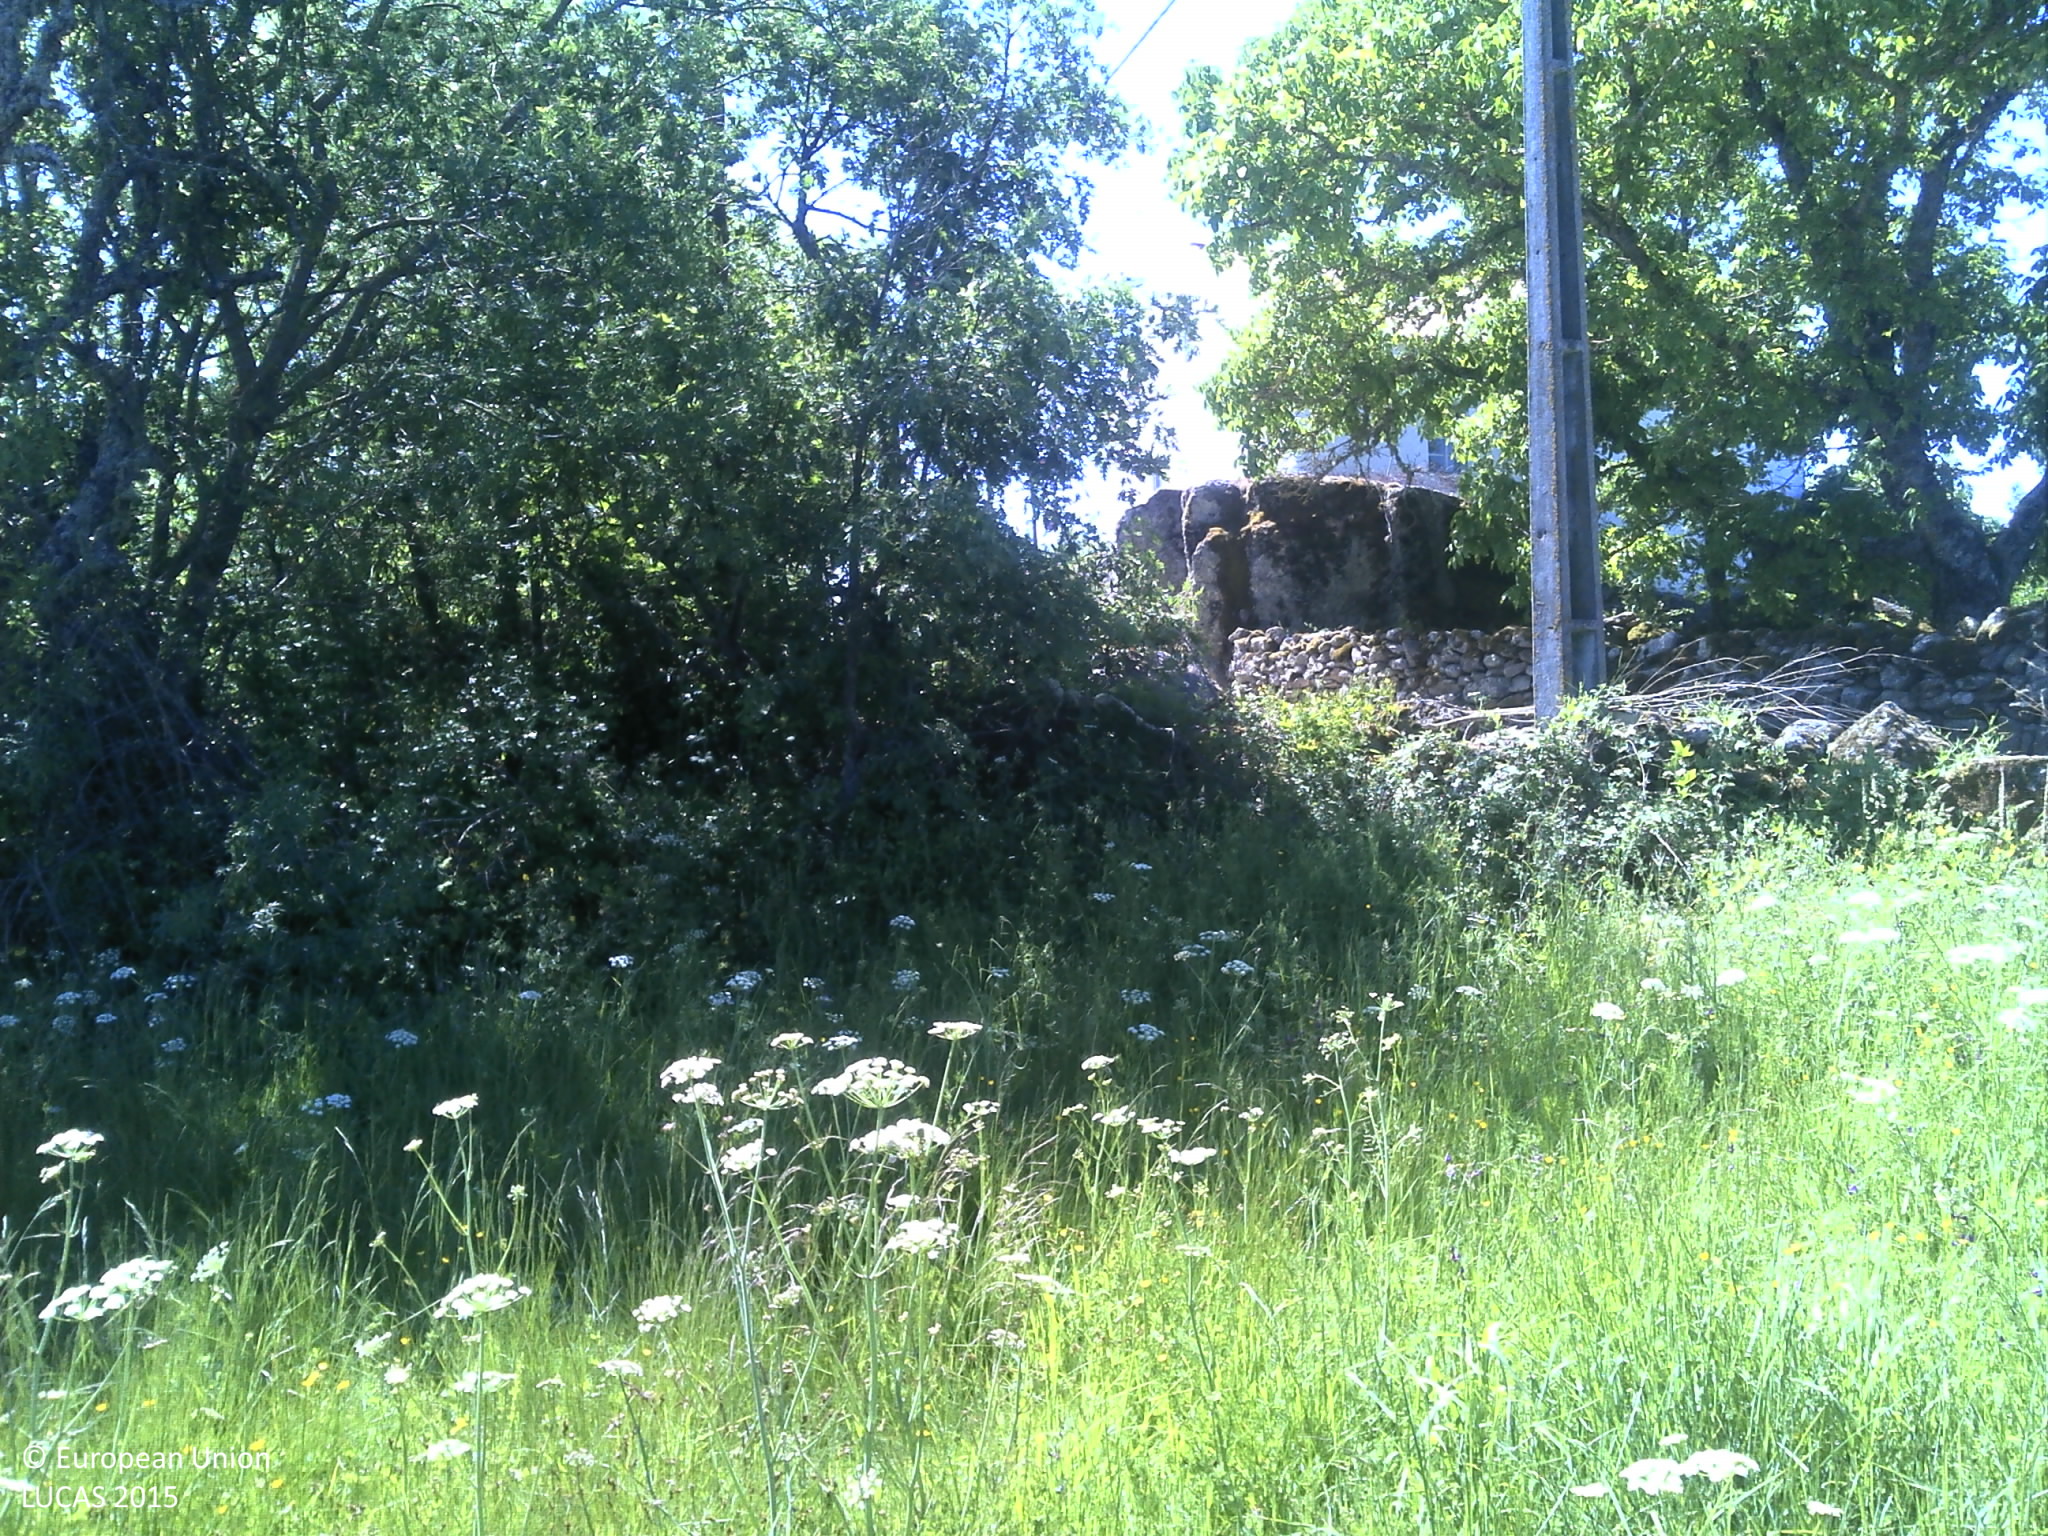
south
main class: Grassland
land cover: Grassland without tree/shrub cover
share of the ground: 50 - 75 %
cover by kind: herbaceous plants 65 %, unconsolidated bare surface 25 %, shrubs 5 %
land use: Agriculture (excluding fallow land and kitchen gardens)
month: May
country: PT
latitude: 40.5962
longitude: -7.1071
